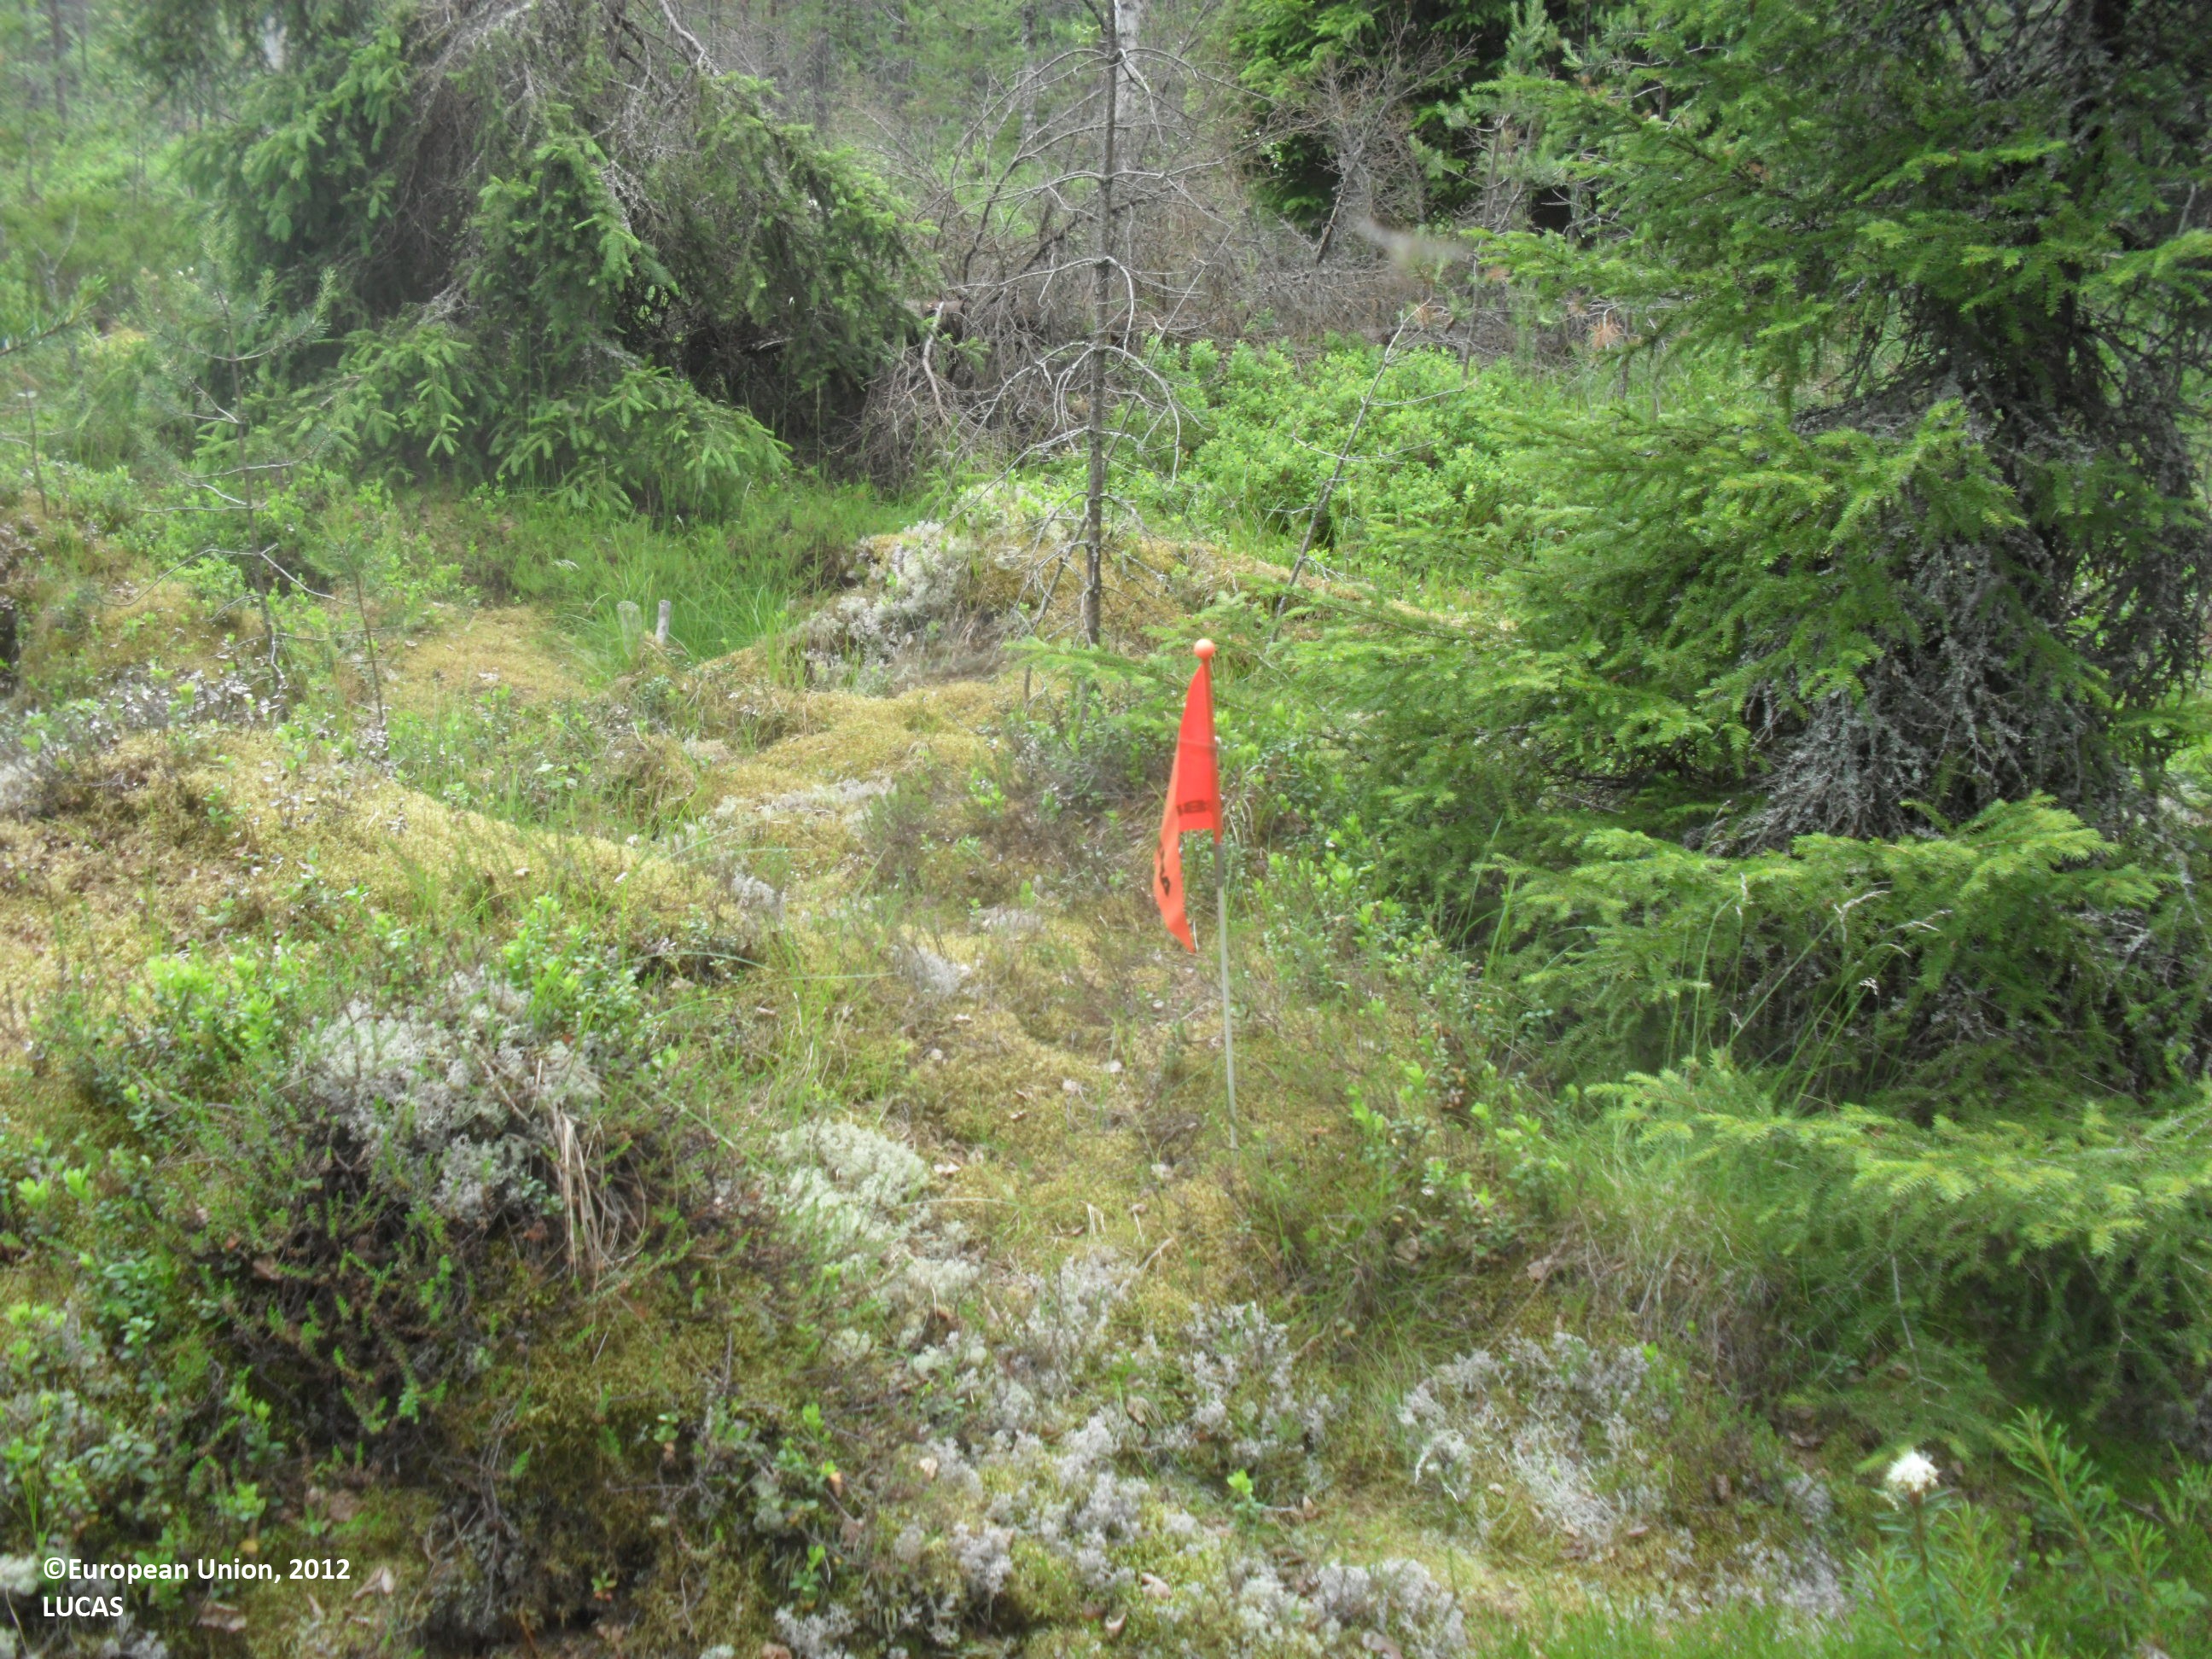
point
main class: Woodland
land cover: Other mixed woodland
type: boreal forest
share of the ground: 25 - 50 %
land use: Forestry
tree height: > 5 m
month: July
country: FI
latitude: 63.4916
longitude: 23.8645
